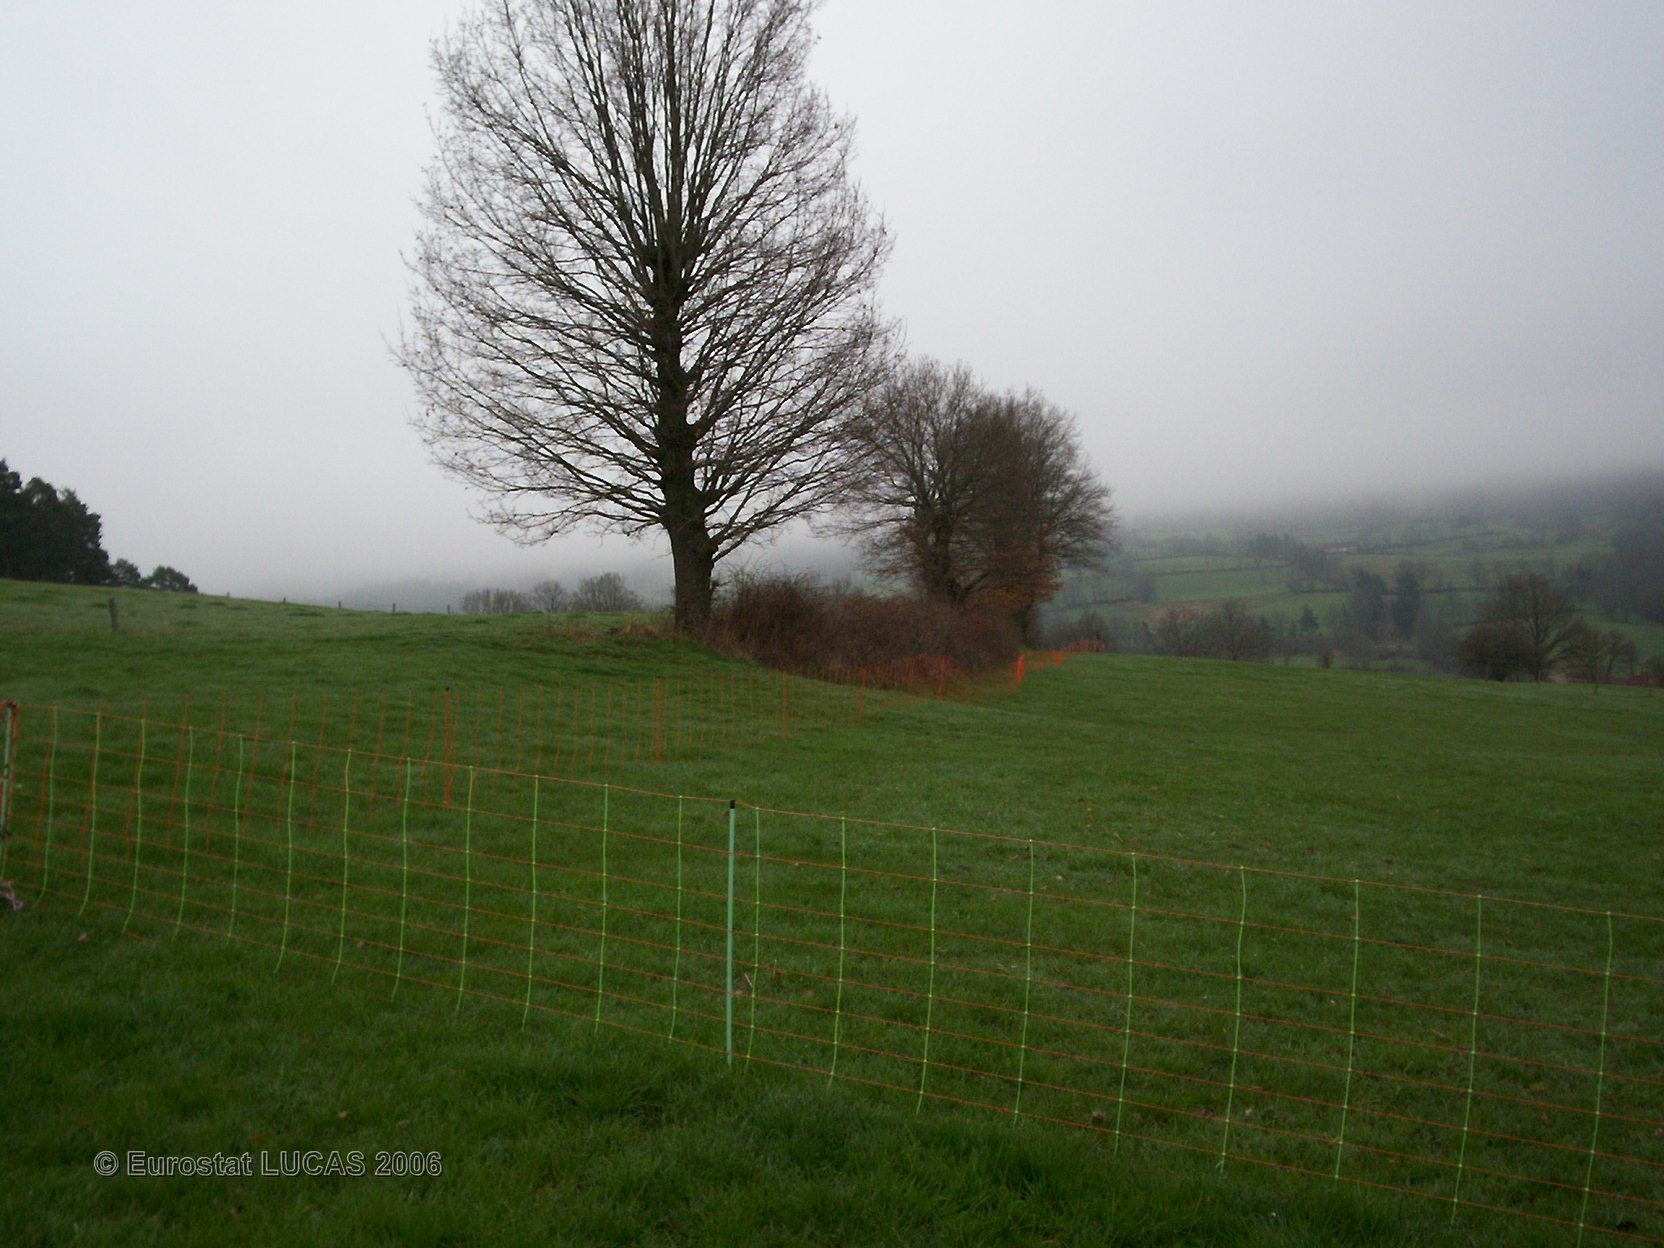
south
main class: Grassland
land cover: Grassland without tree/shrub cover
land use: Agriculture (excluding fallow land and kitchen gardens)
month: April
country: FR
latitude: 44.9462
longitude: 3.2732
